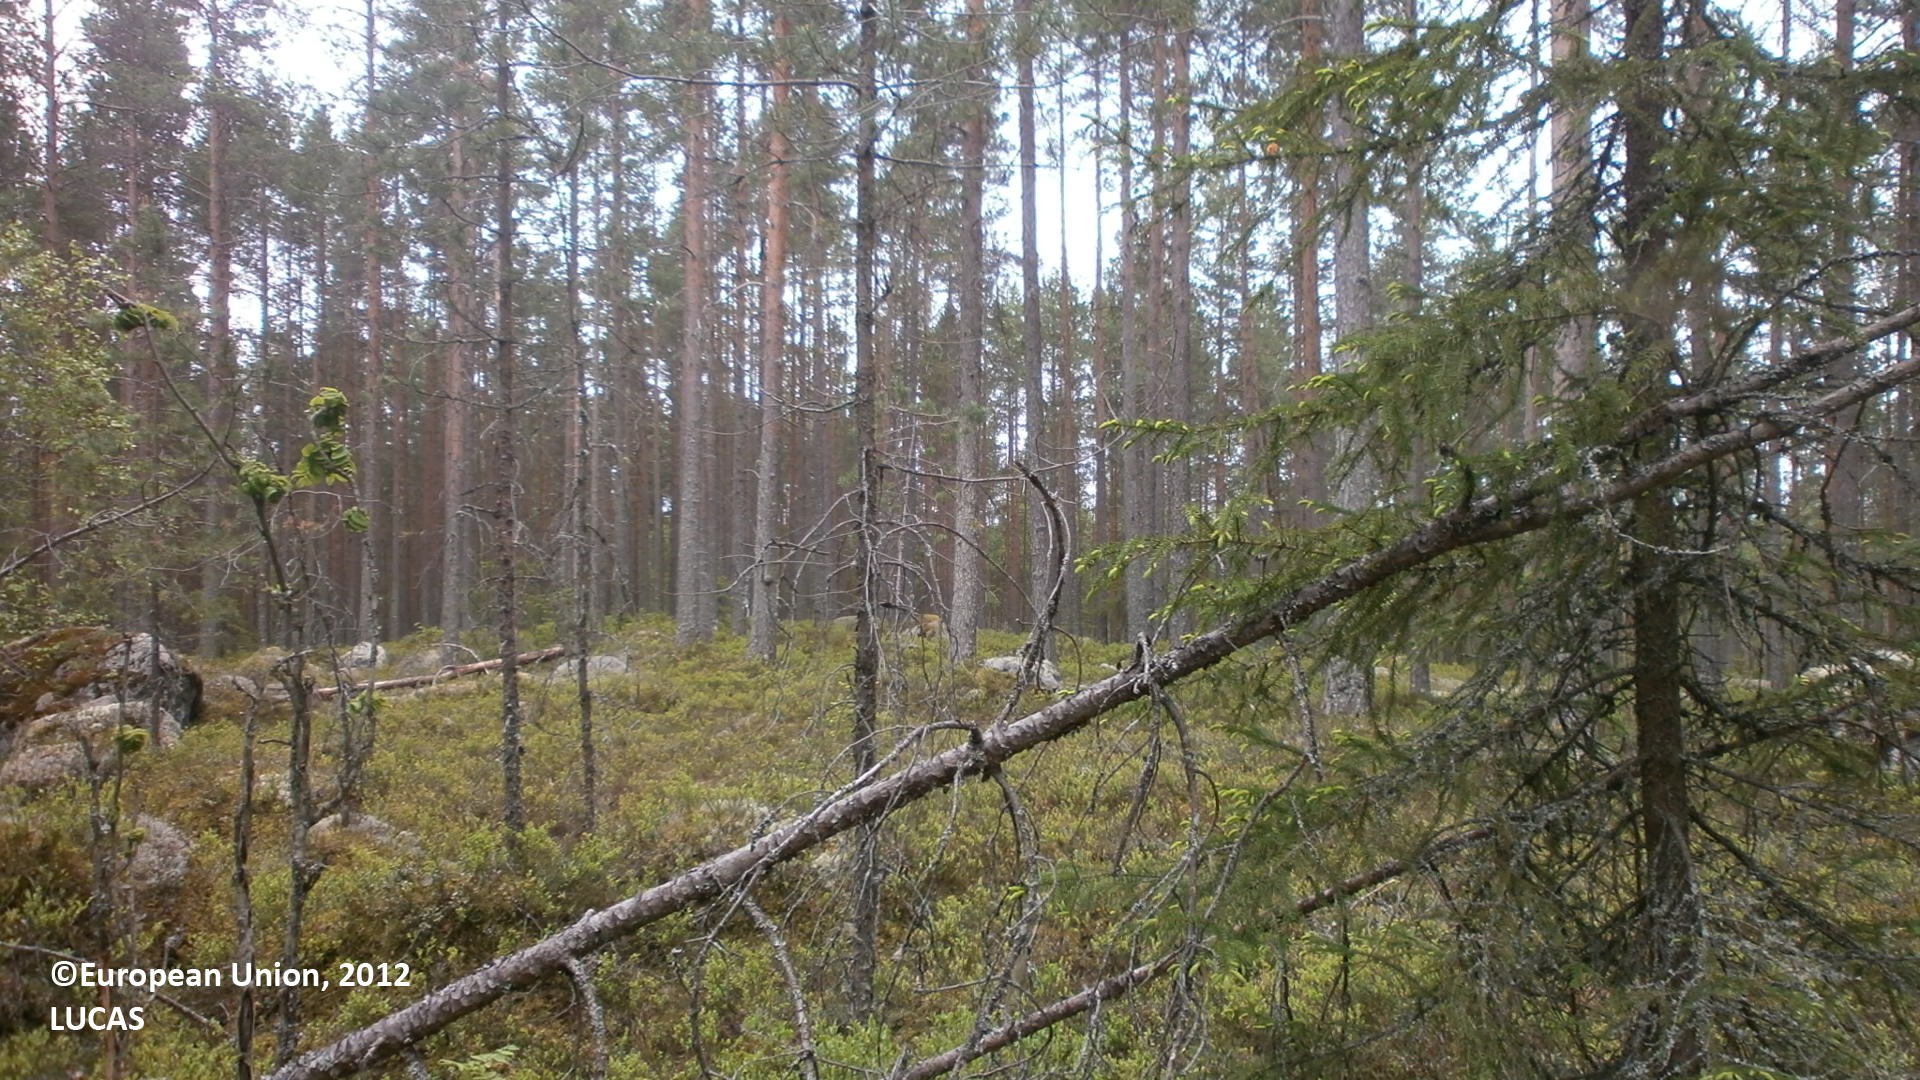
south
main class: Woodland
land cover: Pine dominated coniferous woodland
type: hemiboreal forest and nemoral coniferous forest and mixed broadleaved-coniferous forest
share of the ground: 25 - 50 %
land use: Forestry
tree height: > 5 m
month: June
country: FI
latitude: 64.4410
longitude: 25.1437
